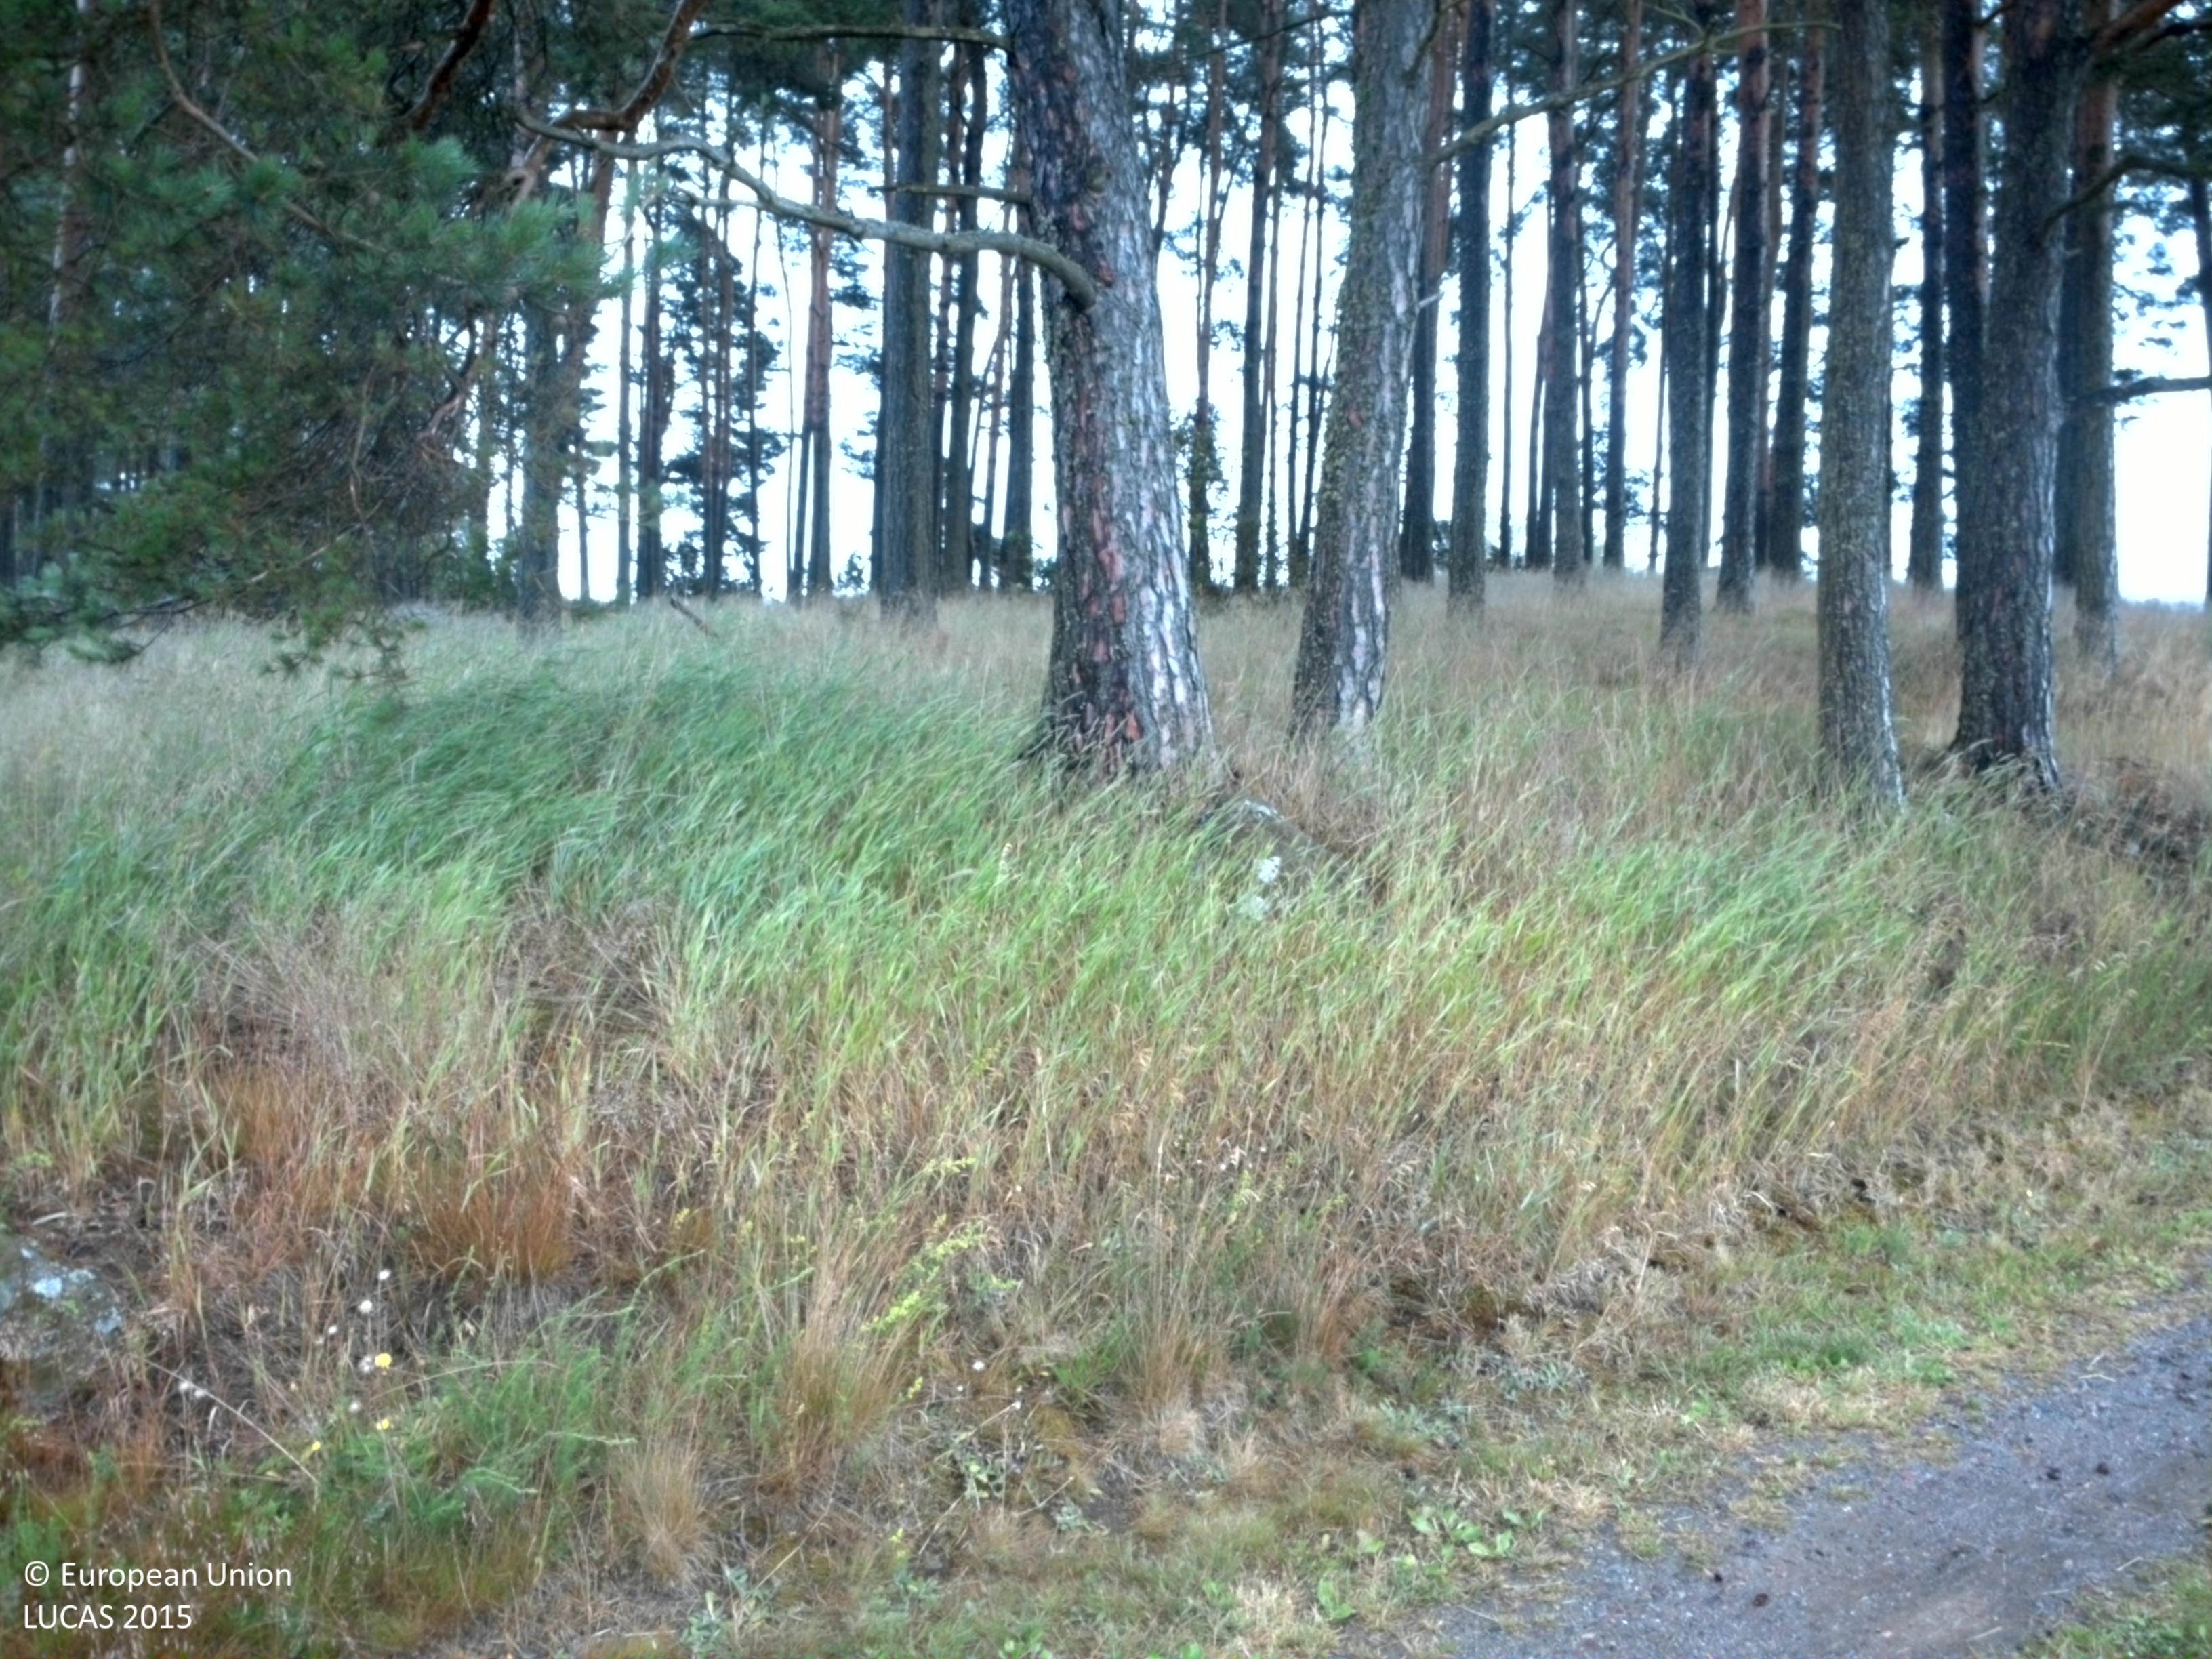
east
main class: Cropland
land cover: Dry pulses
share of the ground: > 75 %
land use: Agriculture (excluding fallow land and kitchen gardens)
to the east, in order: Dry pulses; Grass margins; Tracks; Pine dominated coniferous woodland; Grassland without tree/shrub cover; Ditches and canals; Grass margins; Common wheat
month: July
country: SE
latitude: 58.5404
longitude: 13.9275
